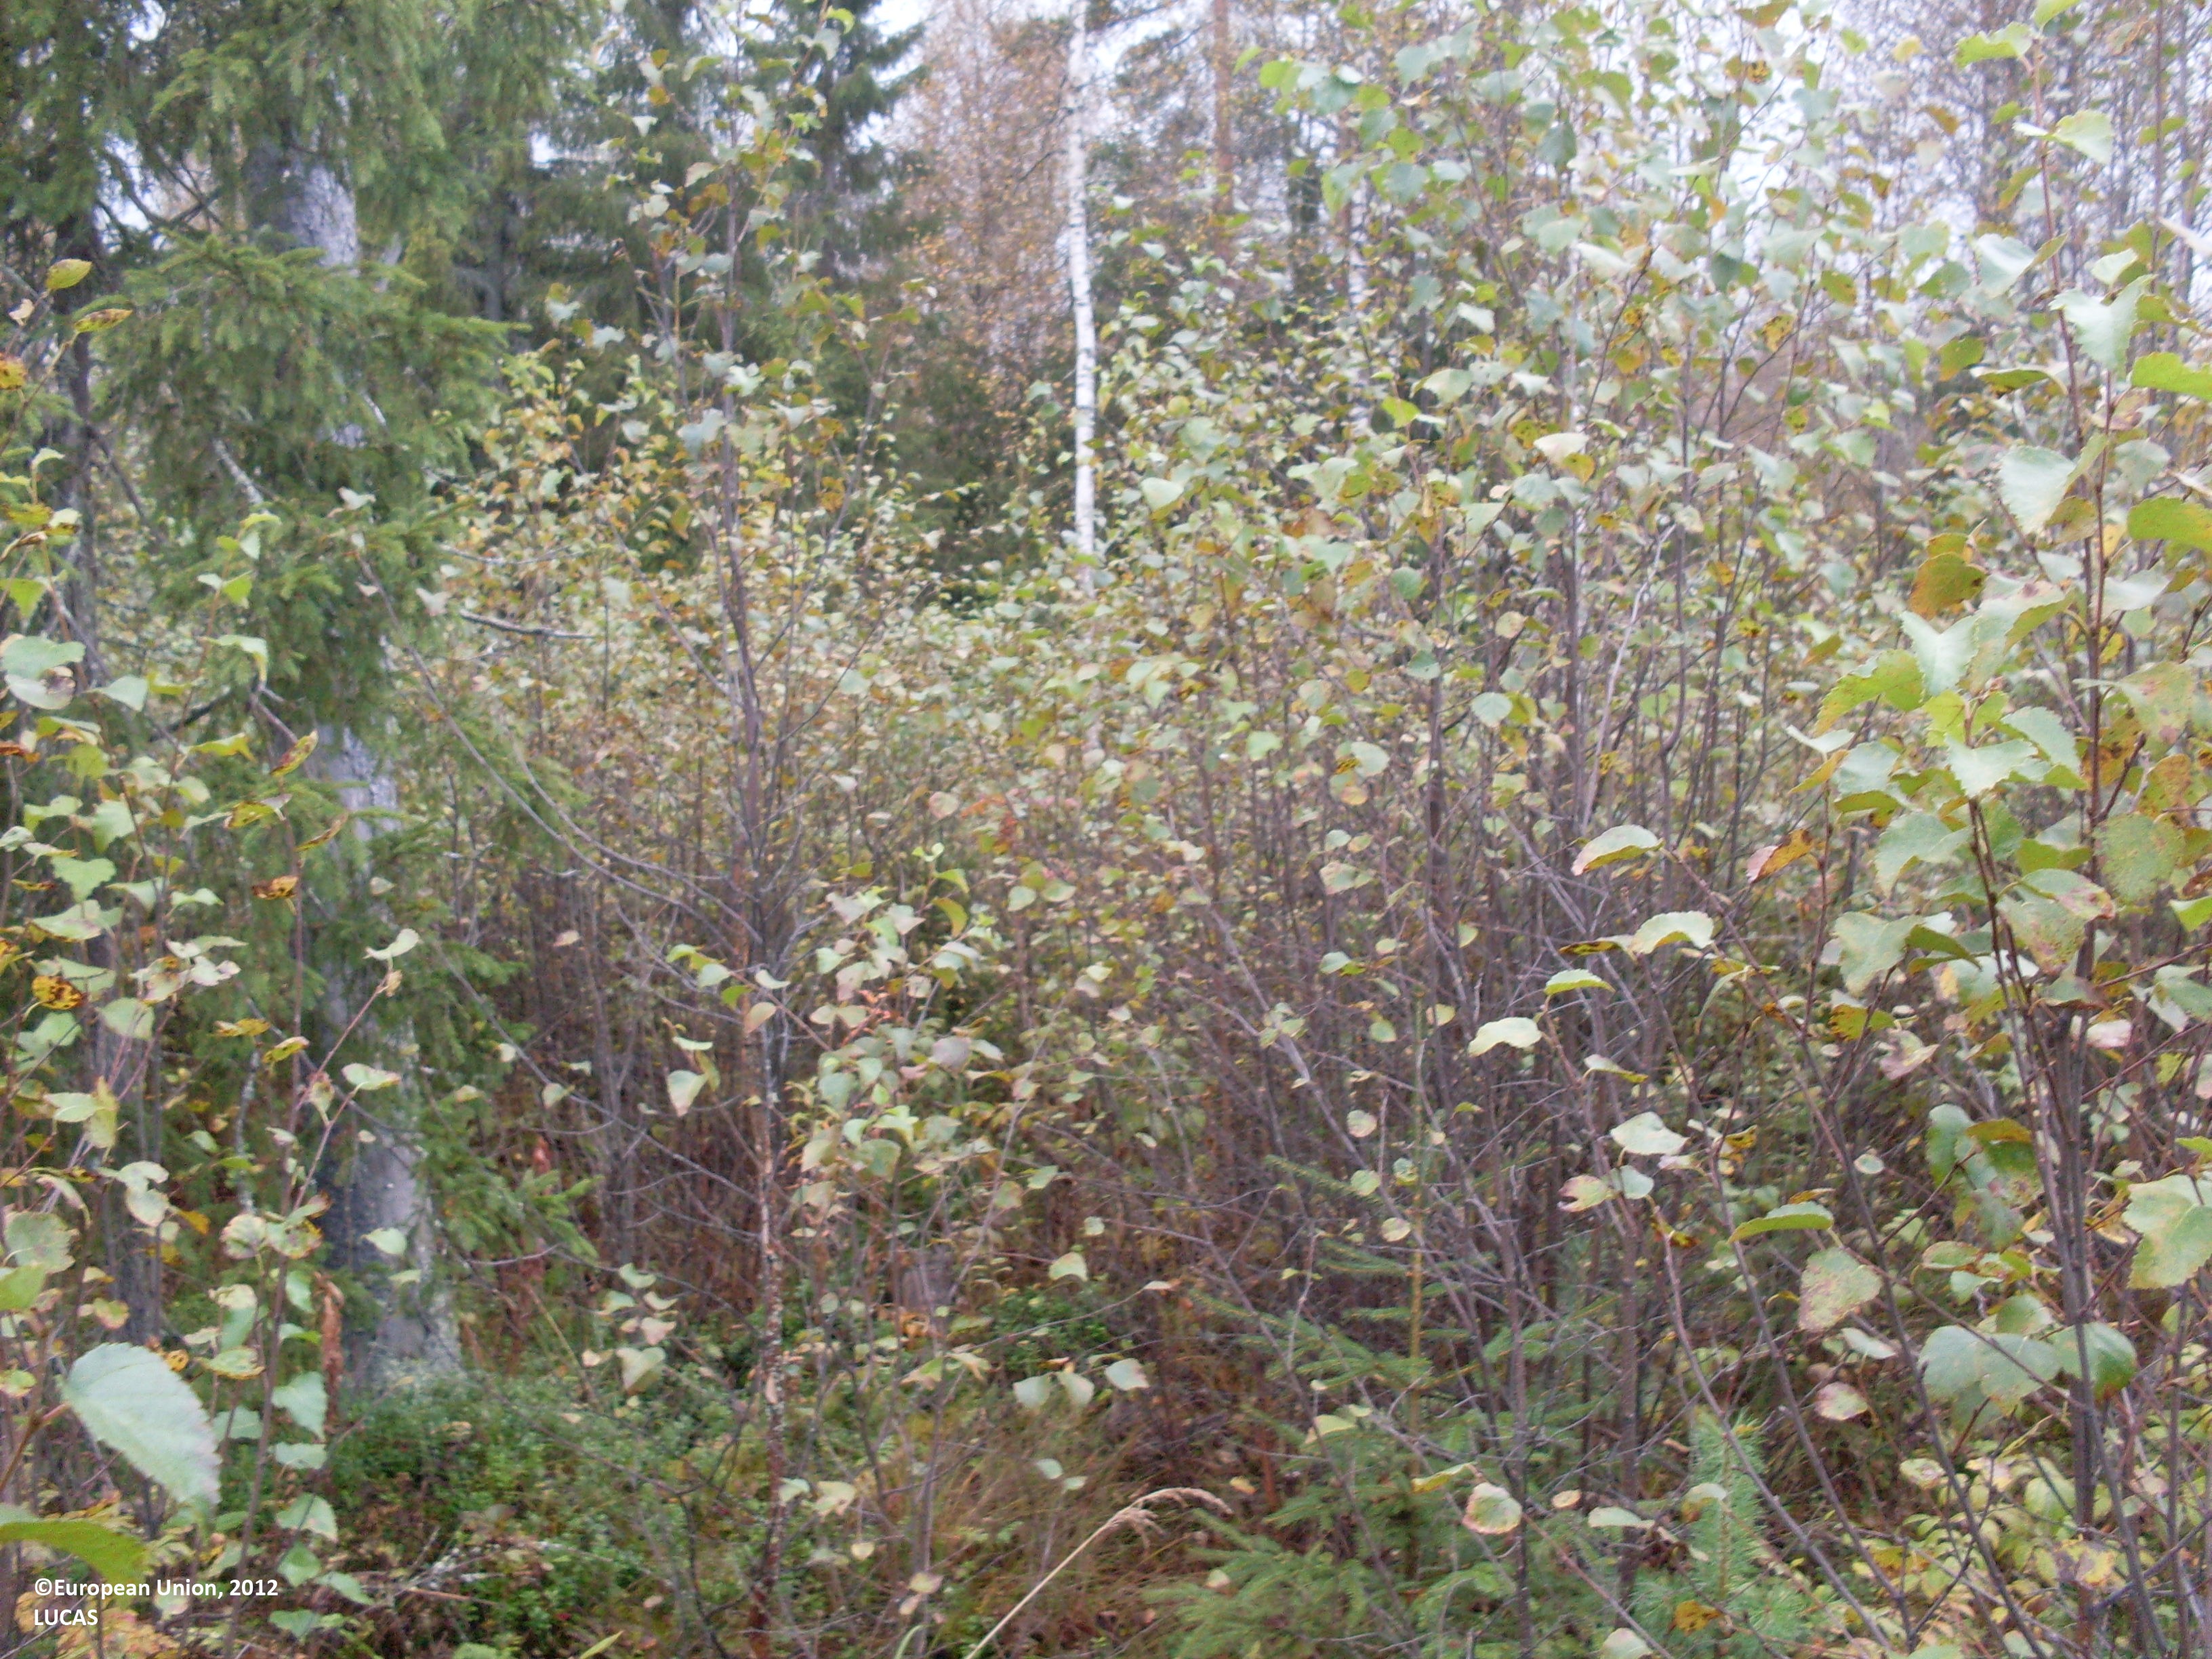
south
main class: Shrubland
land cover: Shrubland with sparse tree cover
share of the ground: > 75 %
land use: Forestry
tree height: < 5 m
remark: Clear cut
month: September
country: FI
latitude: 64.1753
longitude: 28.4704
